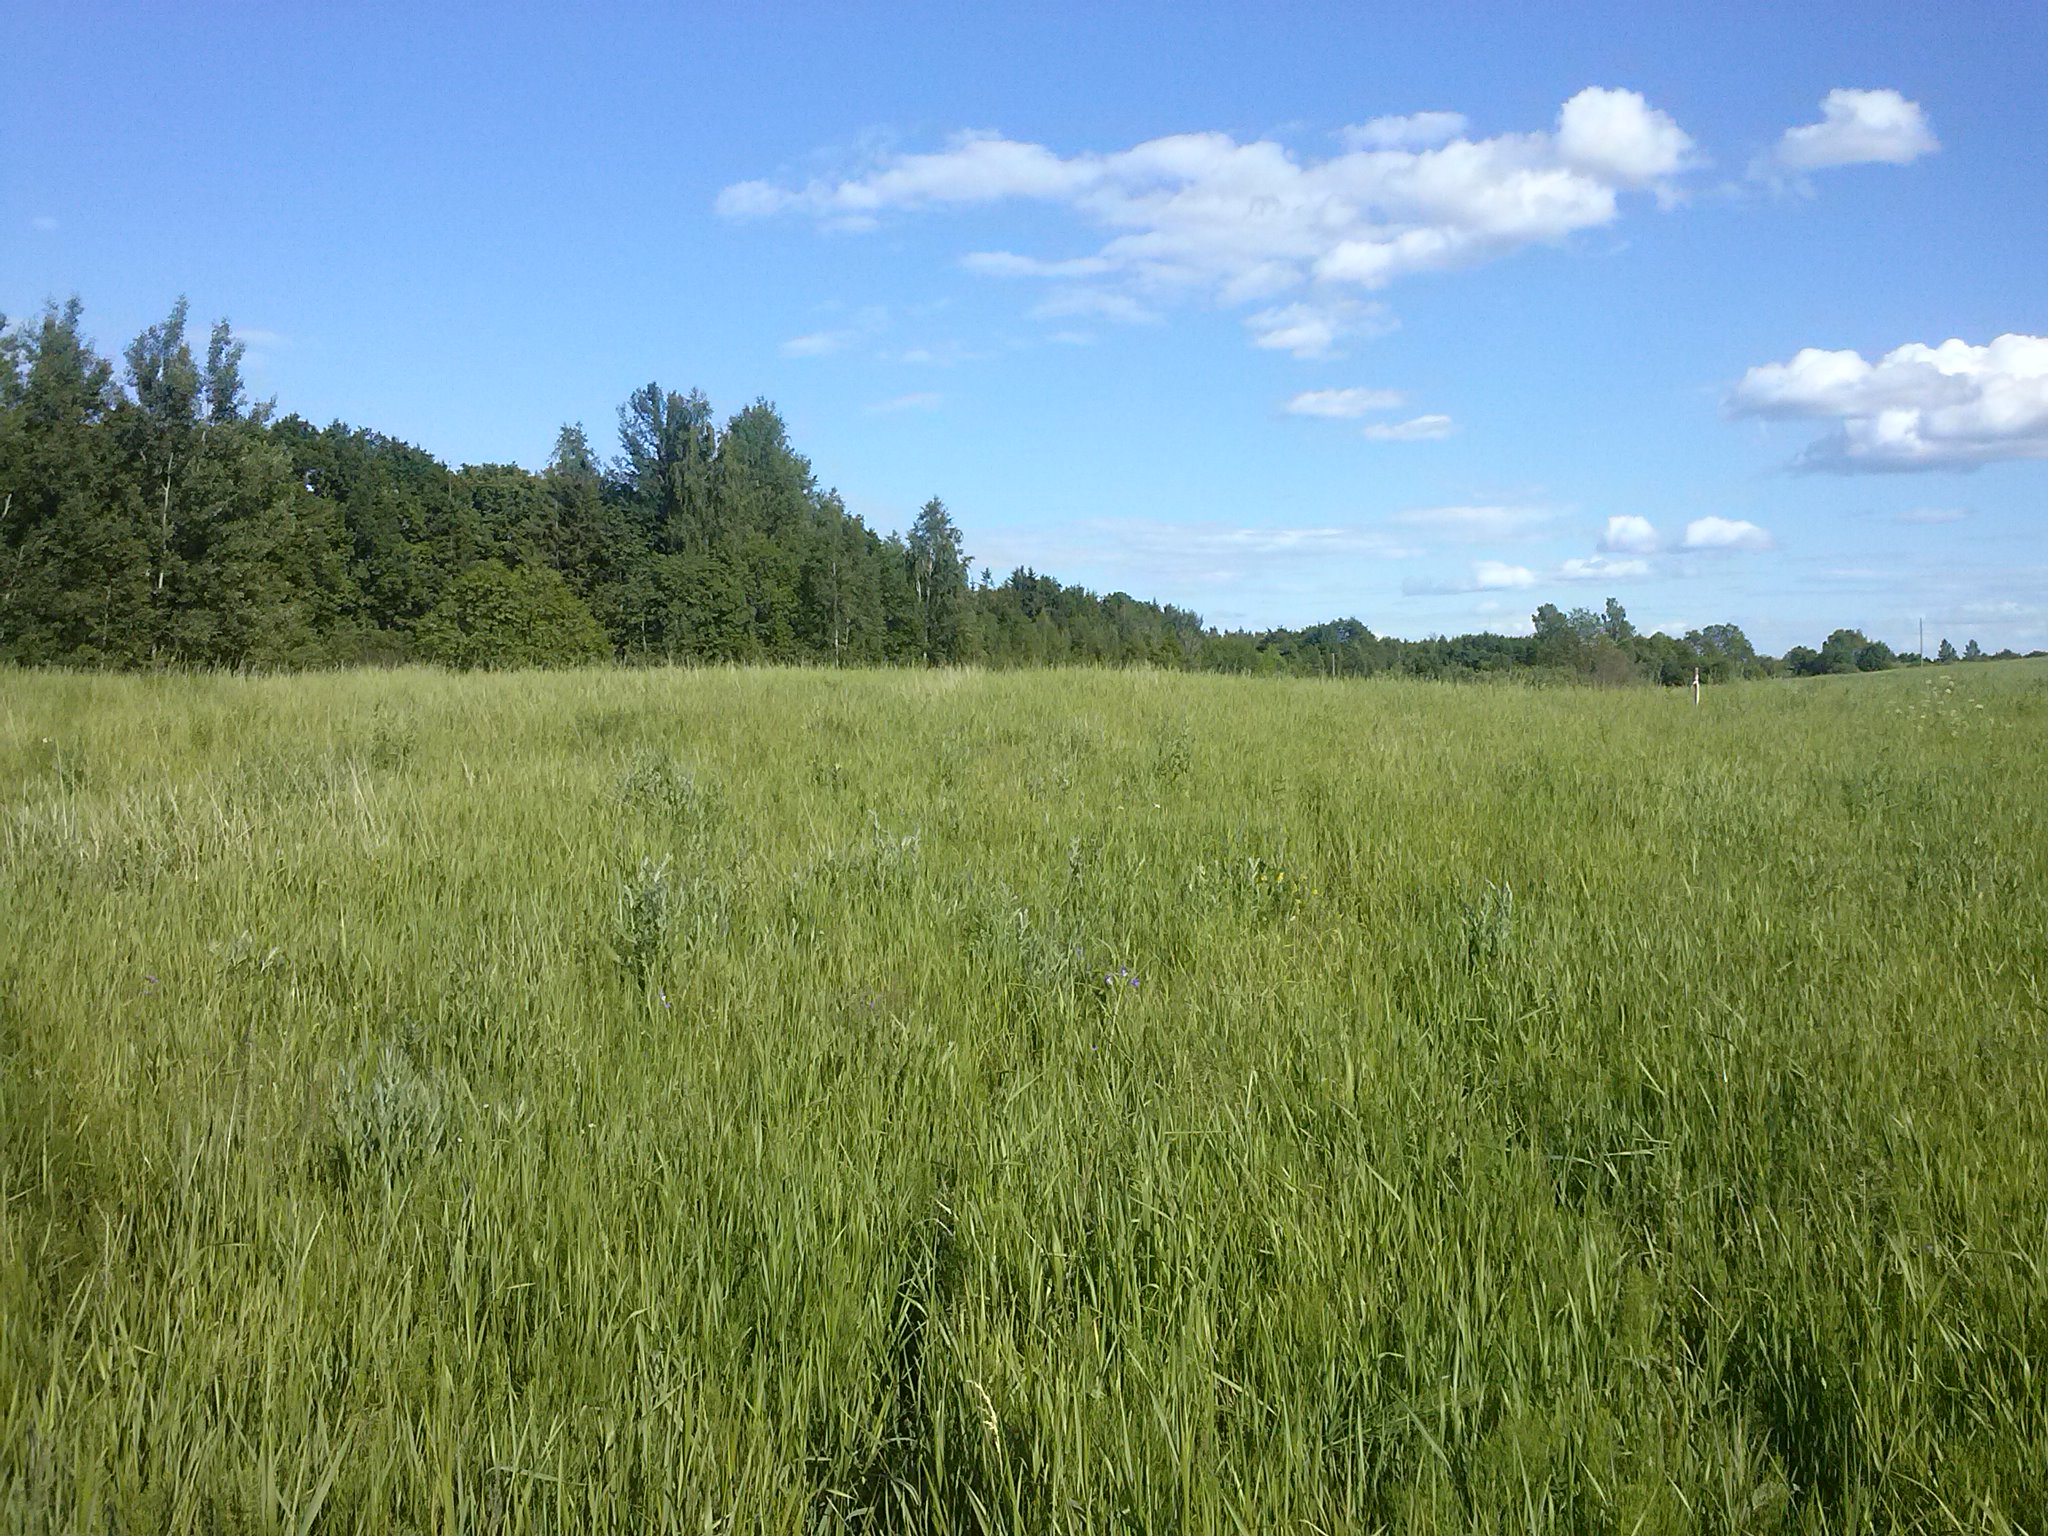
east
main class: Grassland
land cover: Grassland without tree/shrub cover
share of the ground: > 75 %
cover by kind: herbaceous plants 100 %
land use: Agriculture (excluding fallow land and kitchen gardens)
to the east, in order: Grassland without tree/shrub cover; Broadleaved woodland; Ditches and canals; Shrubland without tree cover; Spontaneously vegetated surfaces; Electric lines; Shruby margins; Electric lines; Spontaneously vegetated surfaces; Railways; Spontaneously vegetated surfaces; Broadleaved woodland; Fences; Grassland without tree/shrub cover
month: June
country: LV
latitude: 56.5220
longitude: 27.7593
